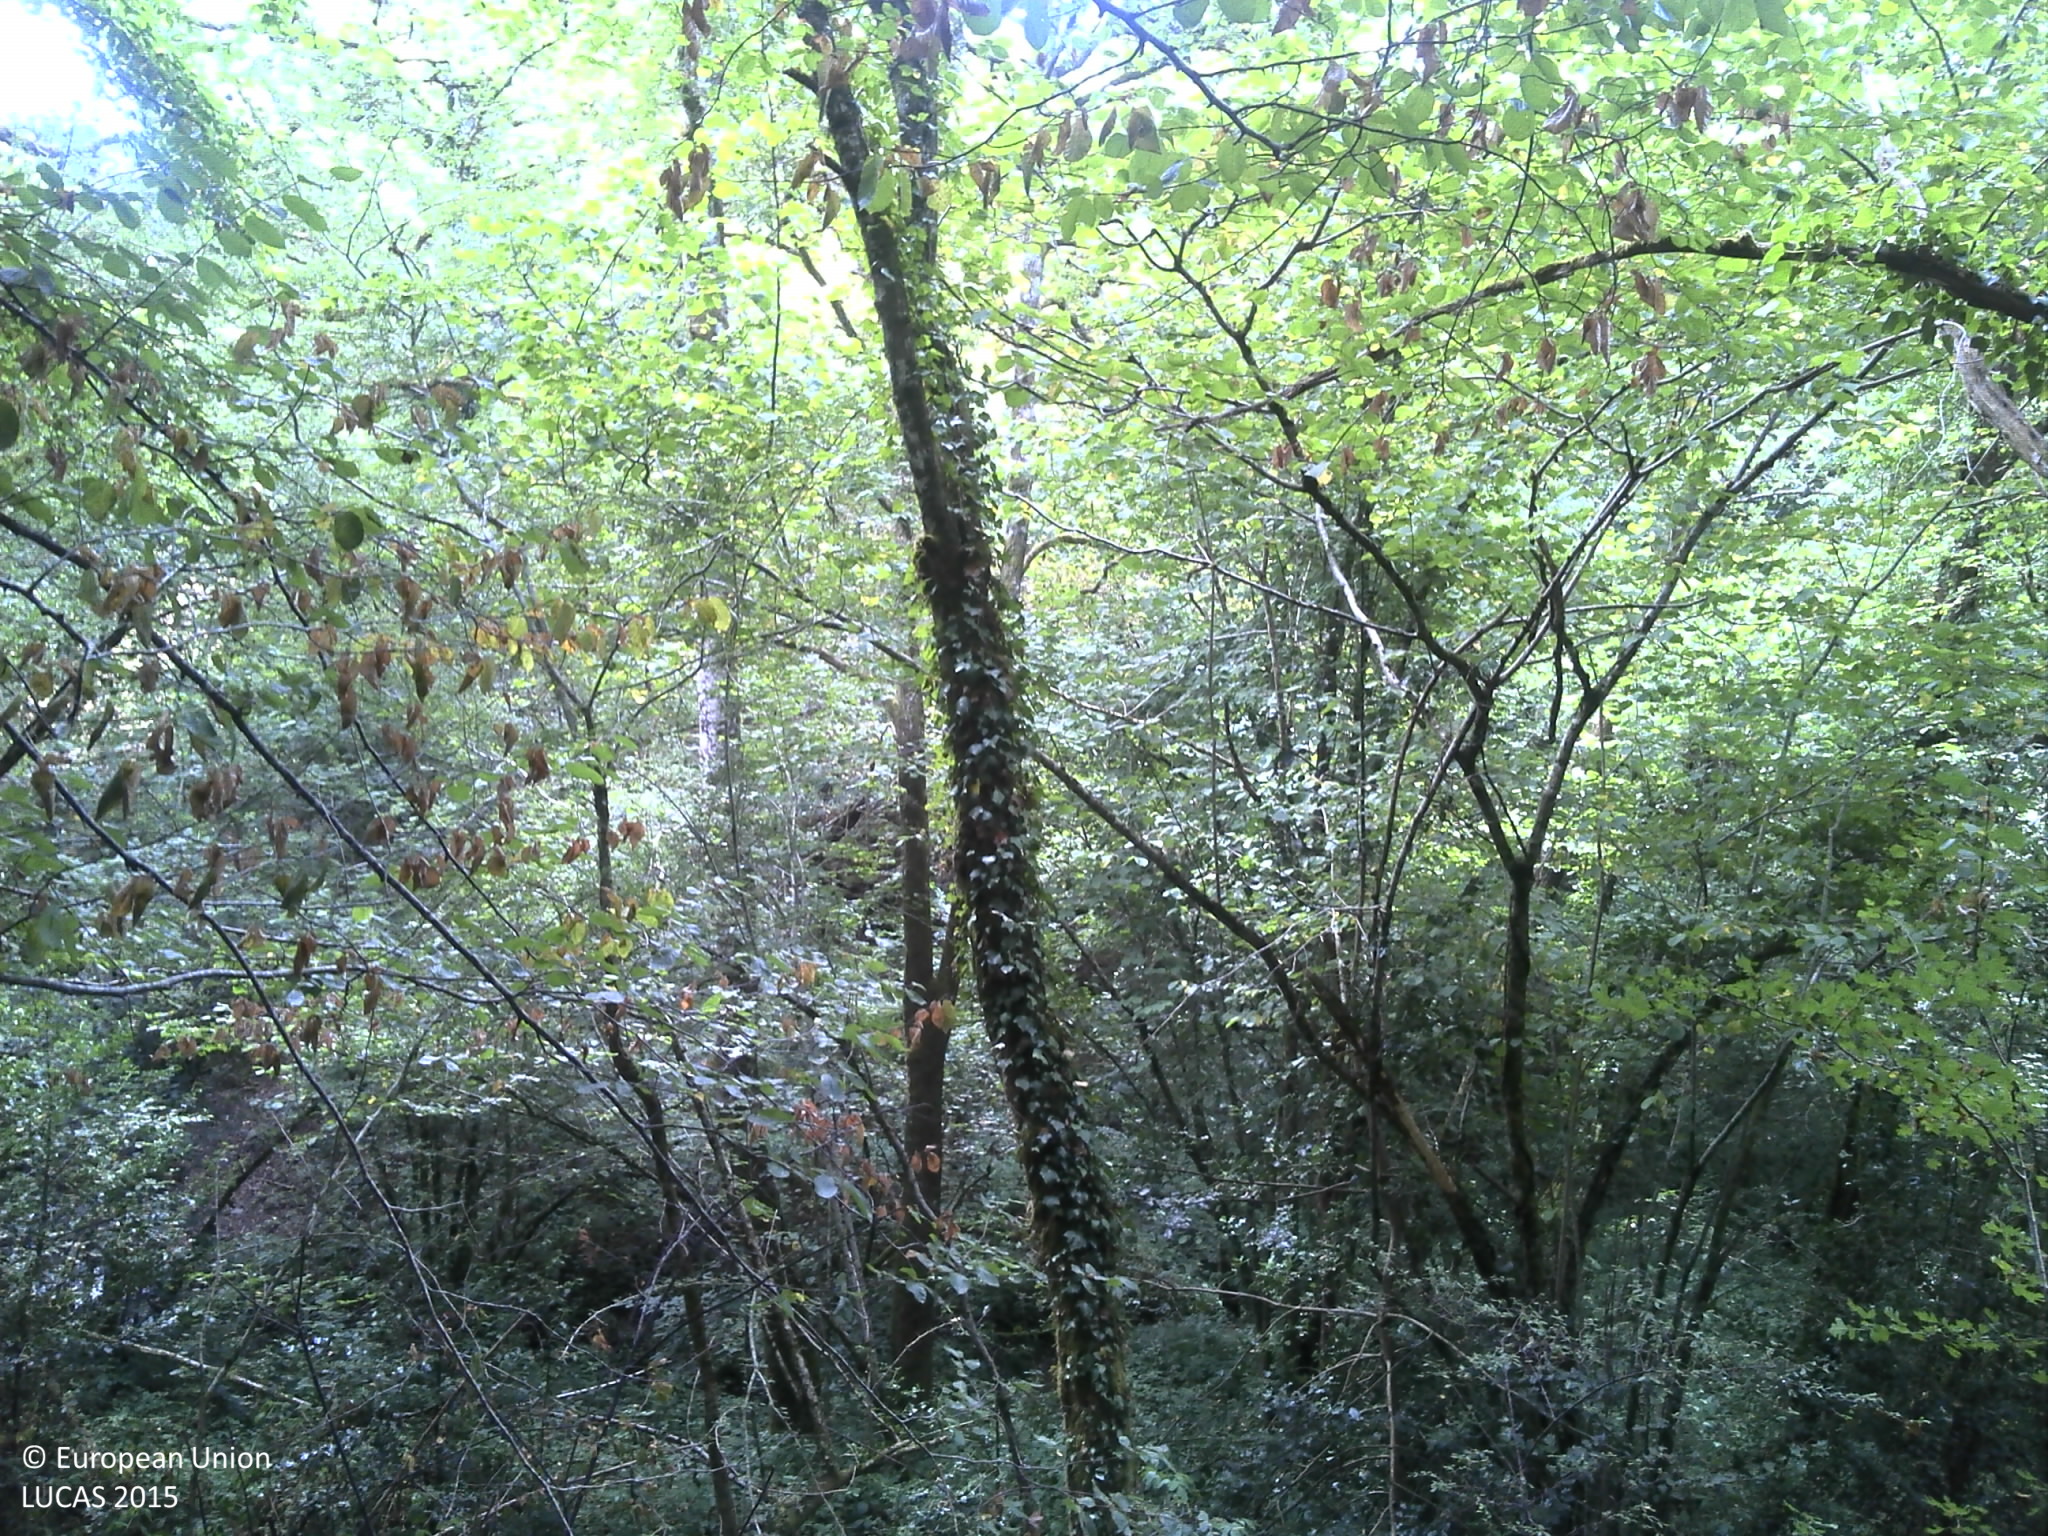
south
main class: Woodland
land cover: Broadleaved woodland
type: mesophytic deciduous forest
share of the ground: > 75 %
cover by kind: broadleaved forest trees 55 %, herbaceous plants 30 %, lichens and mosses 10 %, unconsolidated bare surface 5 %
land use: Semi-natural and natural areas not in use
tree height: > 5 m
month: July
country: FR
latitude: 45.0149
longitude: 1.9404
